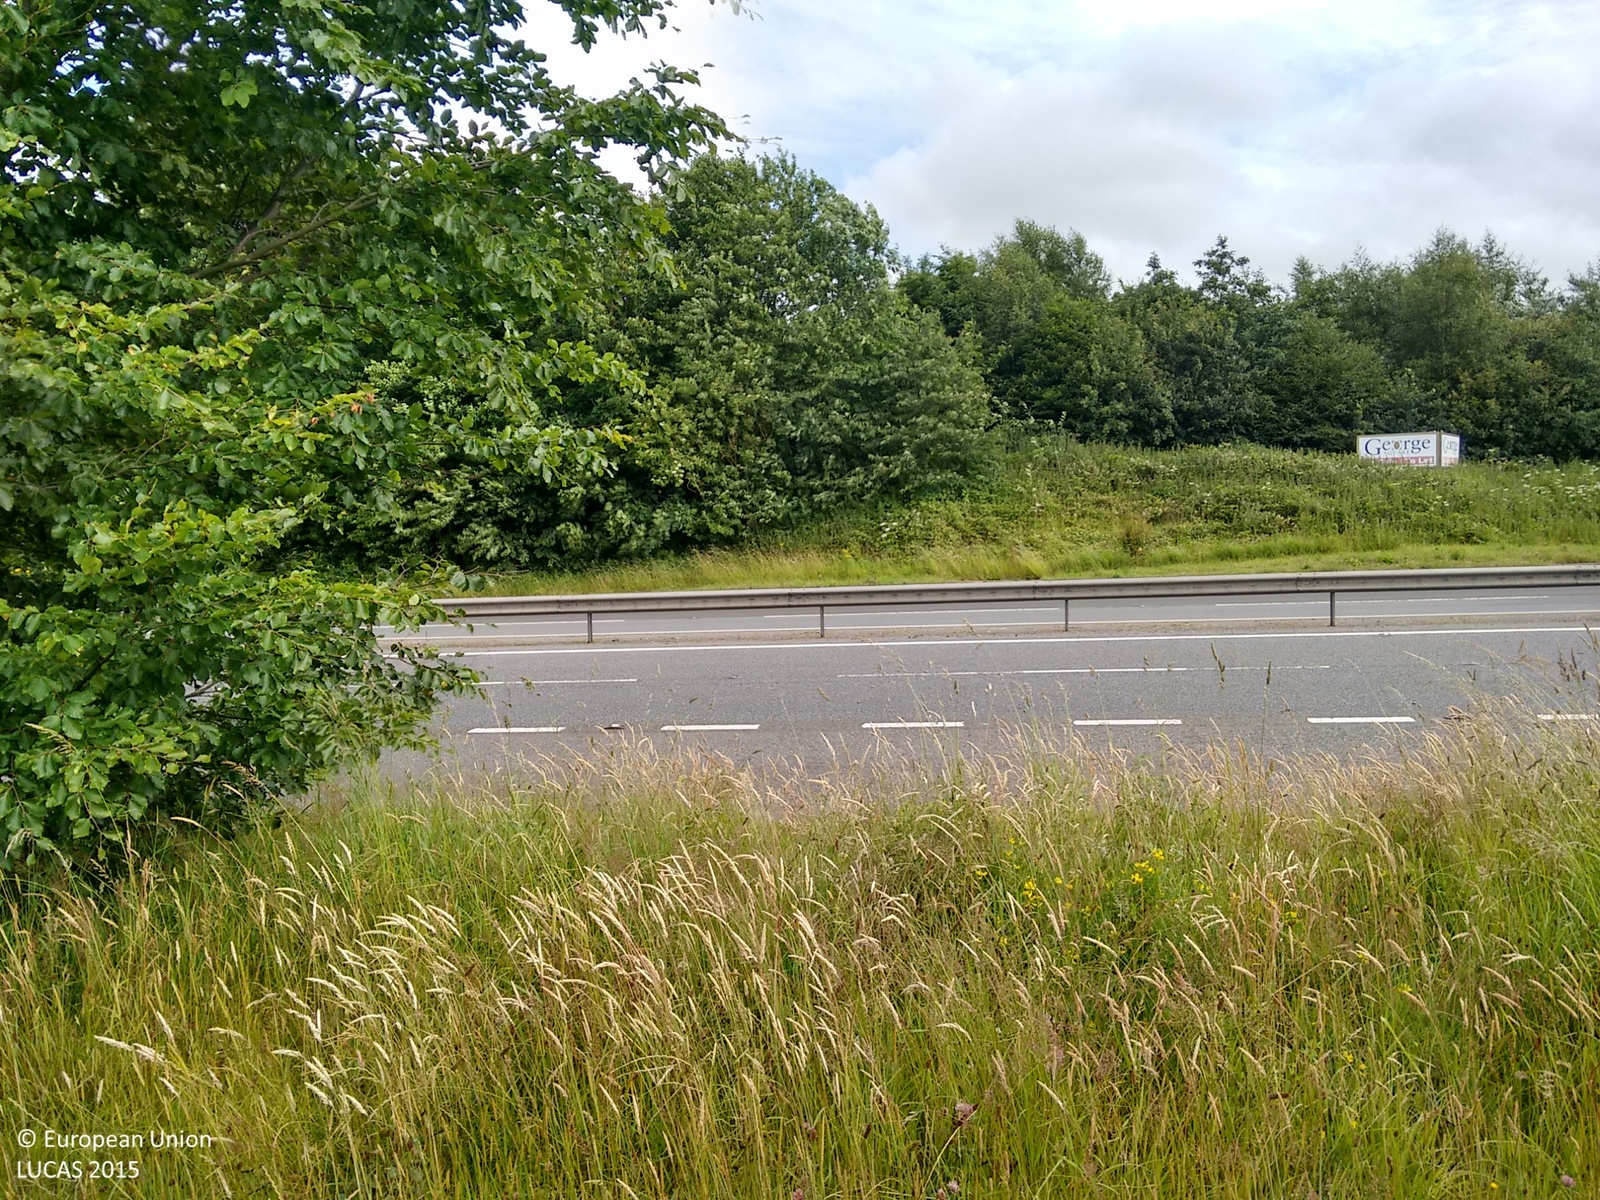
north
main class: Grassland
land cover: Grassland without tree/shrub cover
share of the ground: > 75 %
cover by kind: herbaceous plants 100 %
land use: Semi-natural and natural areas not in use
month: July
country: GB
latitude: 56.0449
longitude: -3.4157
